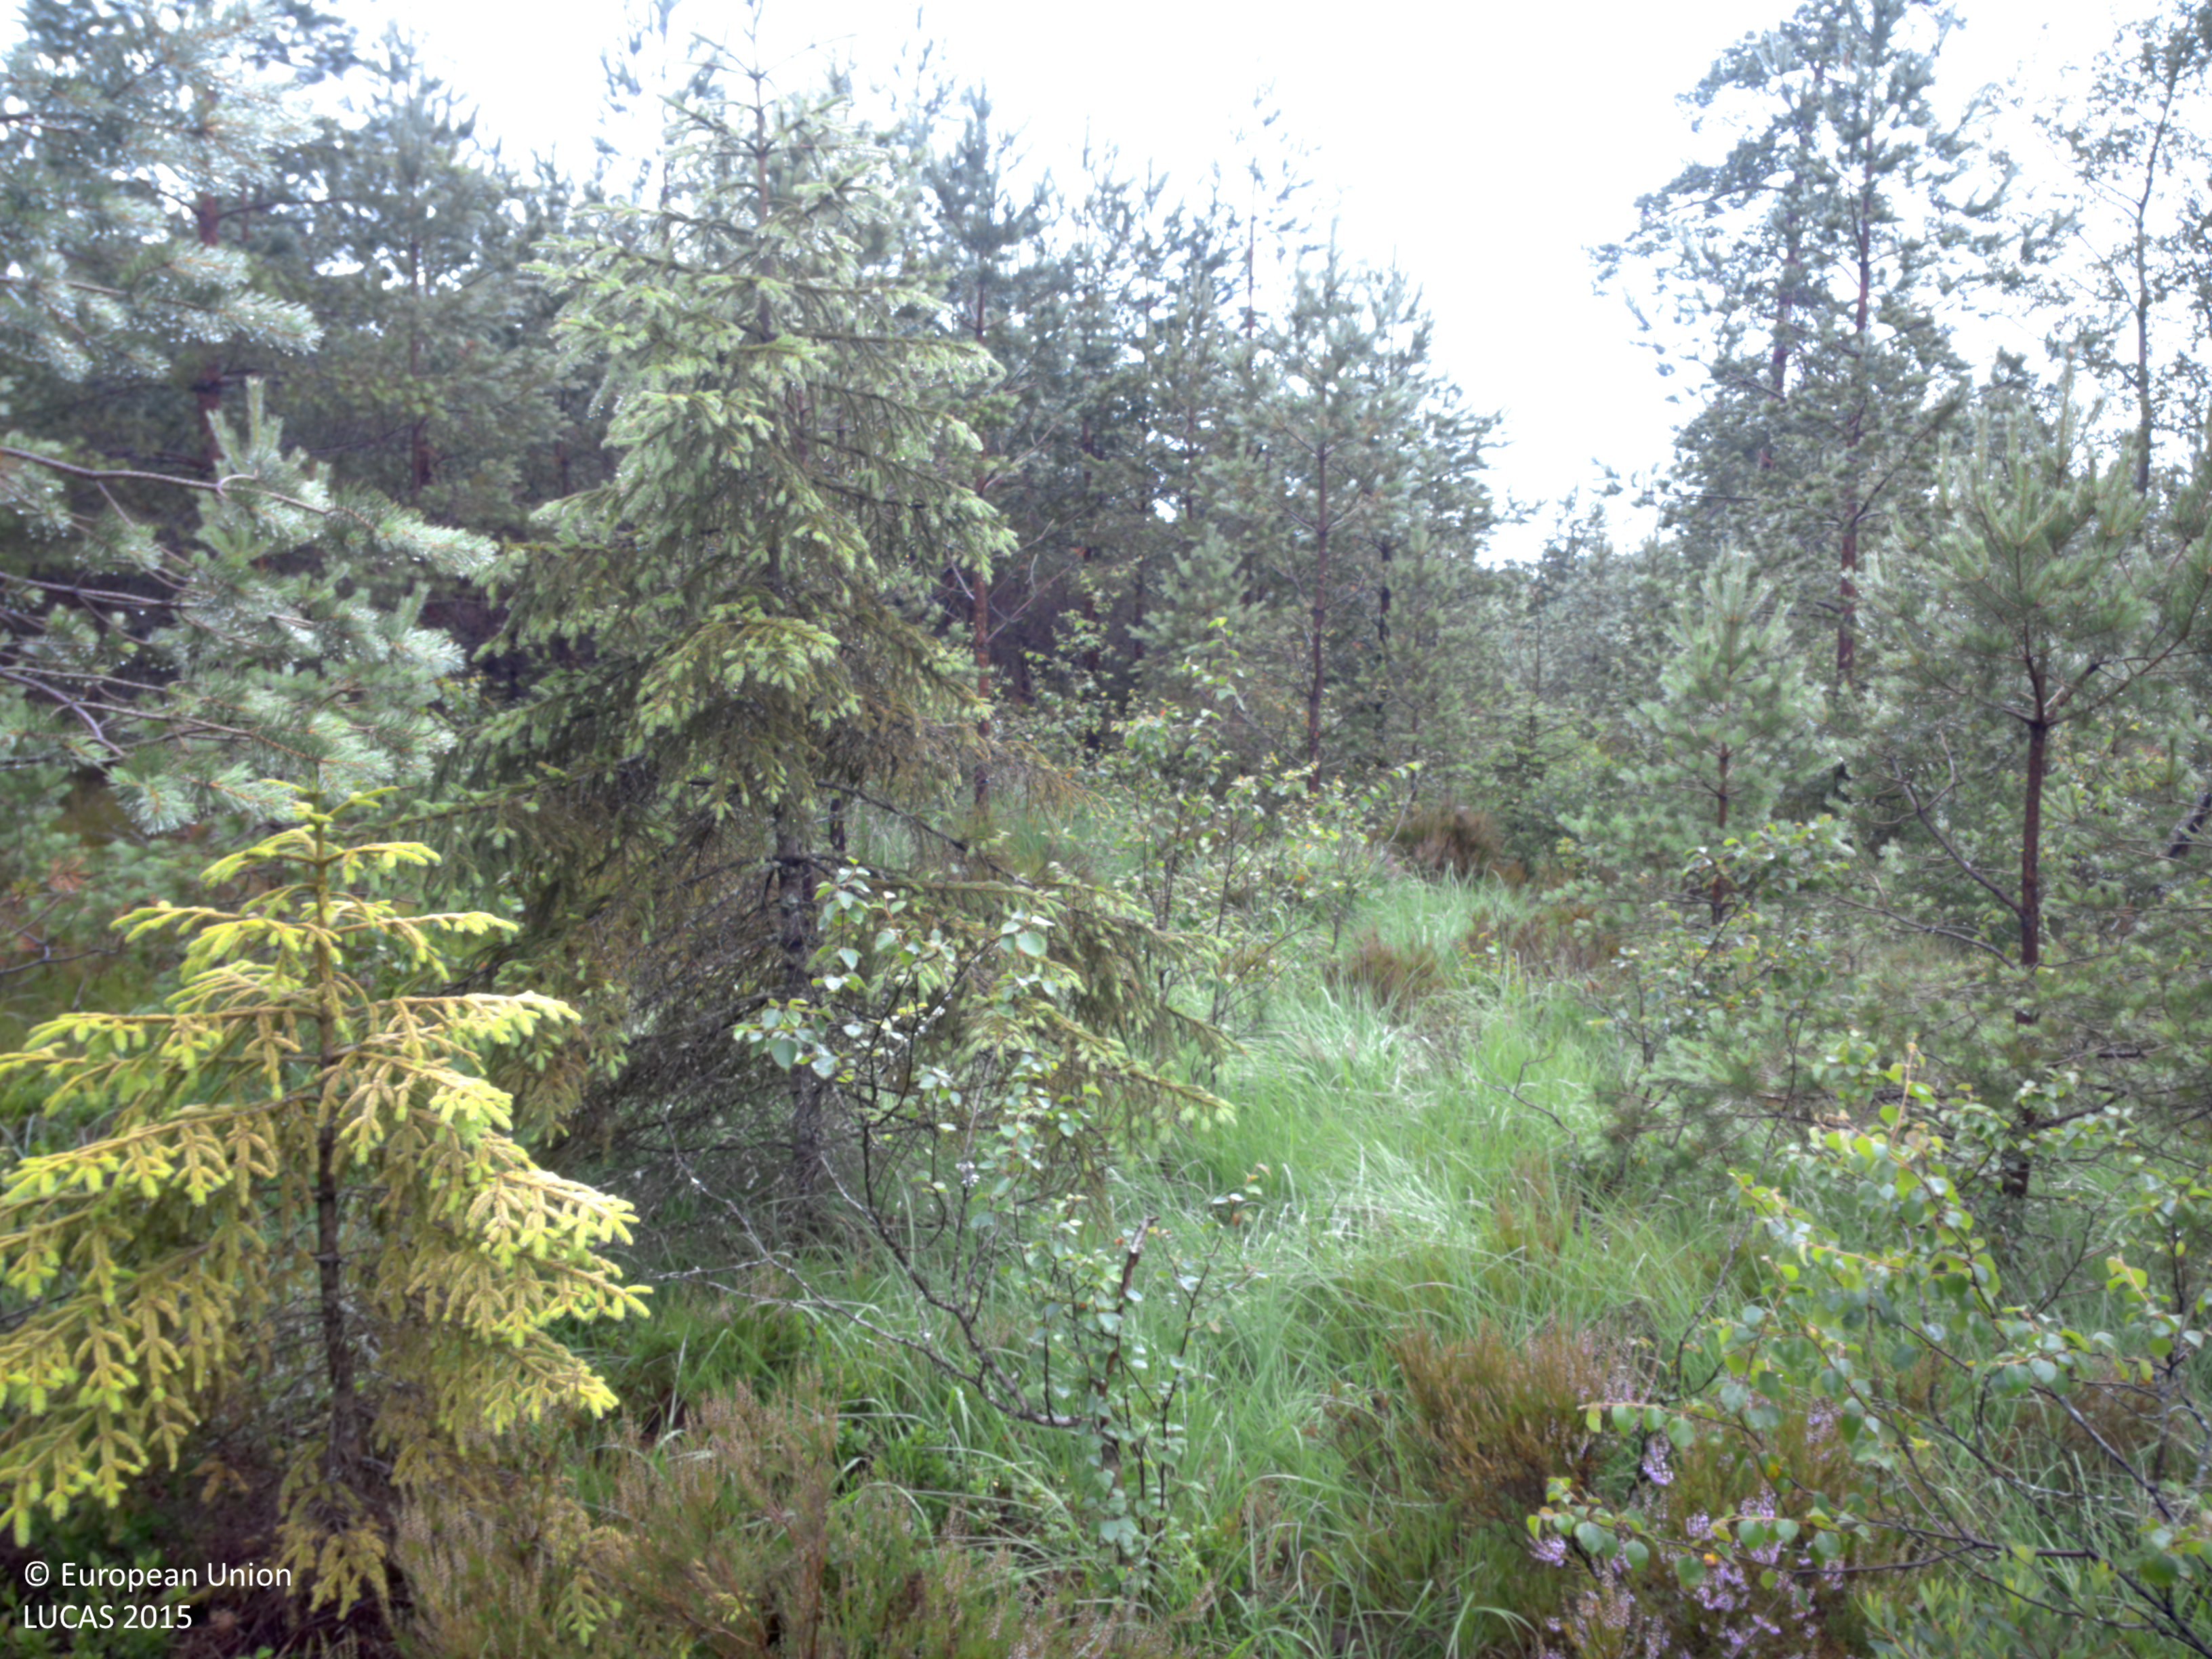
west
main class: Woodland
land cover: Pine dominated mixed woodland
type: boreal forest
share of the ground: 50 - 75 %
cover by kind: coniferous forest trees 40 %, herbaceous plants 30 %, broadleaved forest trees 15 %, shrubs 15 %
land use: Forestry
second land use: Amenities, museums, leisure
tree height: < 5 m
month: July
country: SE
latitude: 58.6944
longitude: 11.7044
